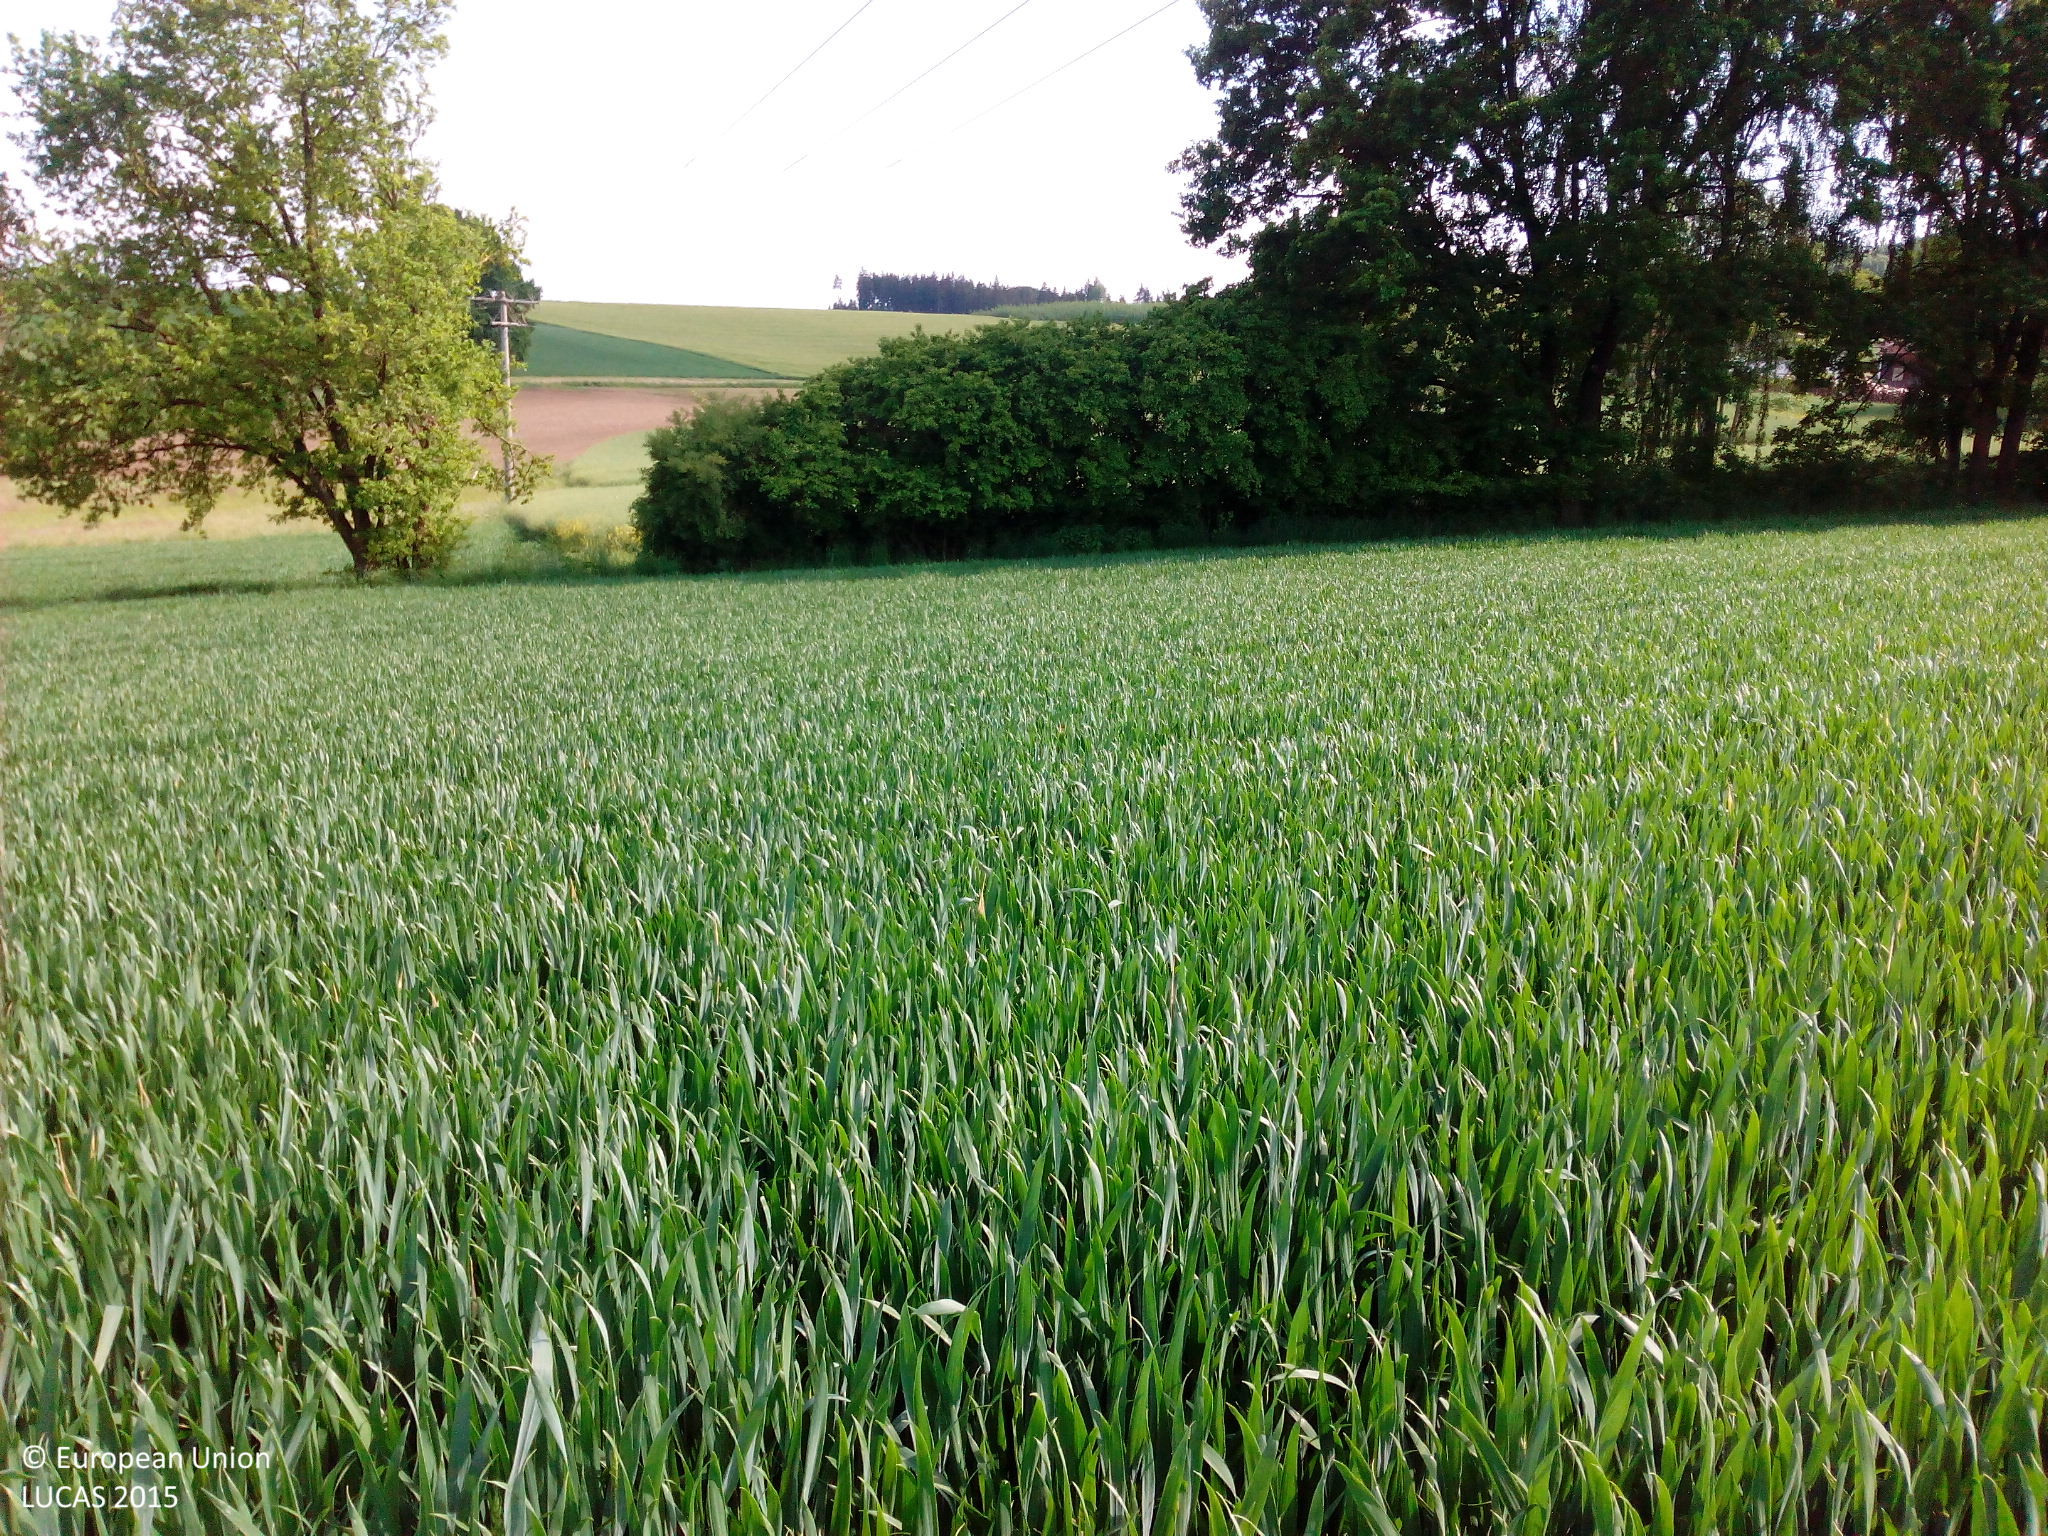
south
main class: Cropland
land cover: Common wheat
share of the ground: > 75 %
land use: Agriculture (excluding fallow land and kitchen gardens)
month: May
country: DE
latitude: 48.7745
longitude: 12.3534
